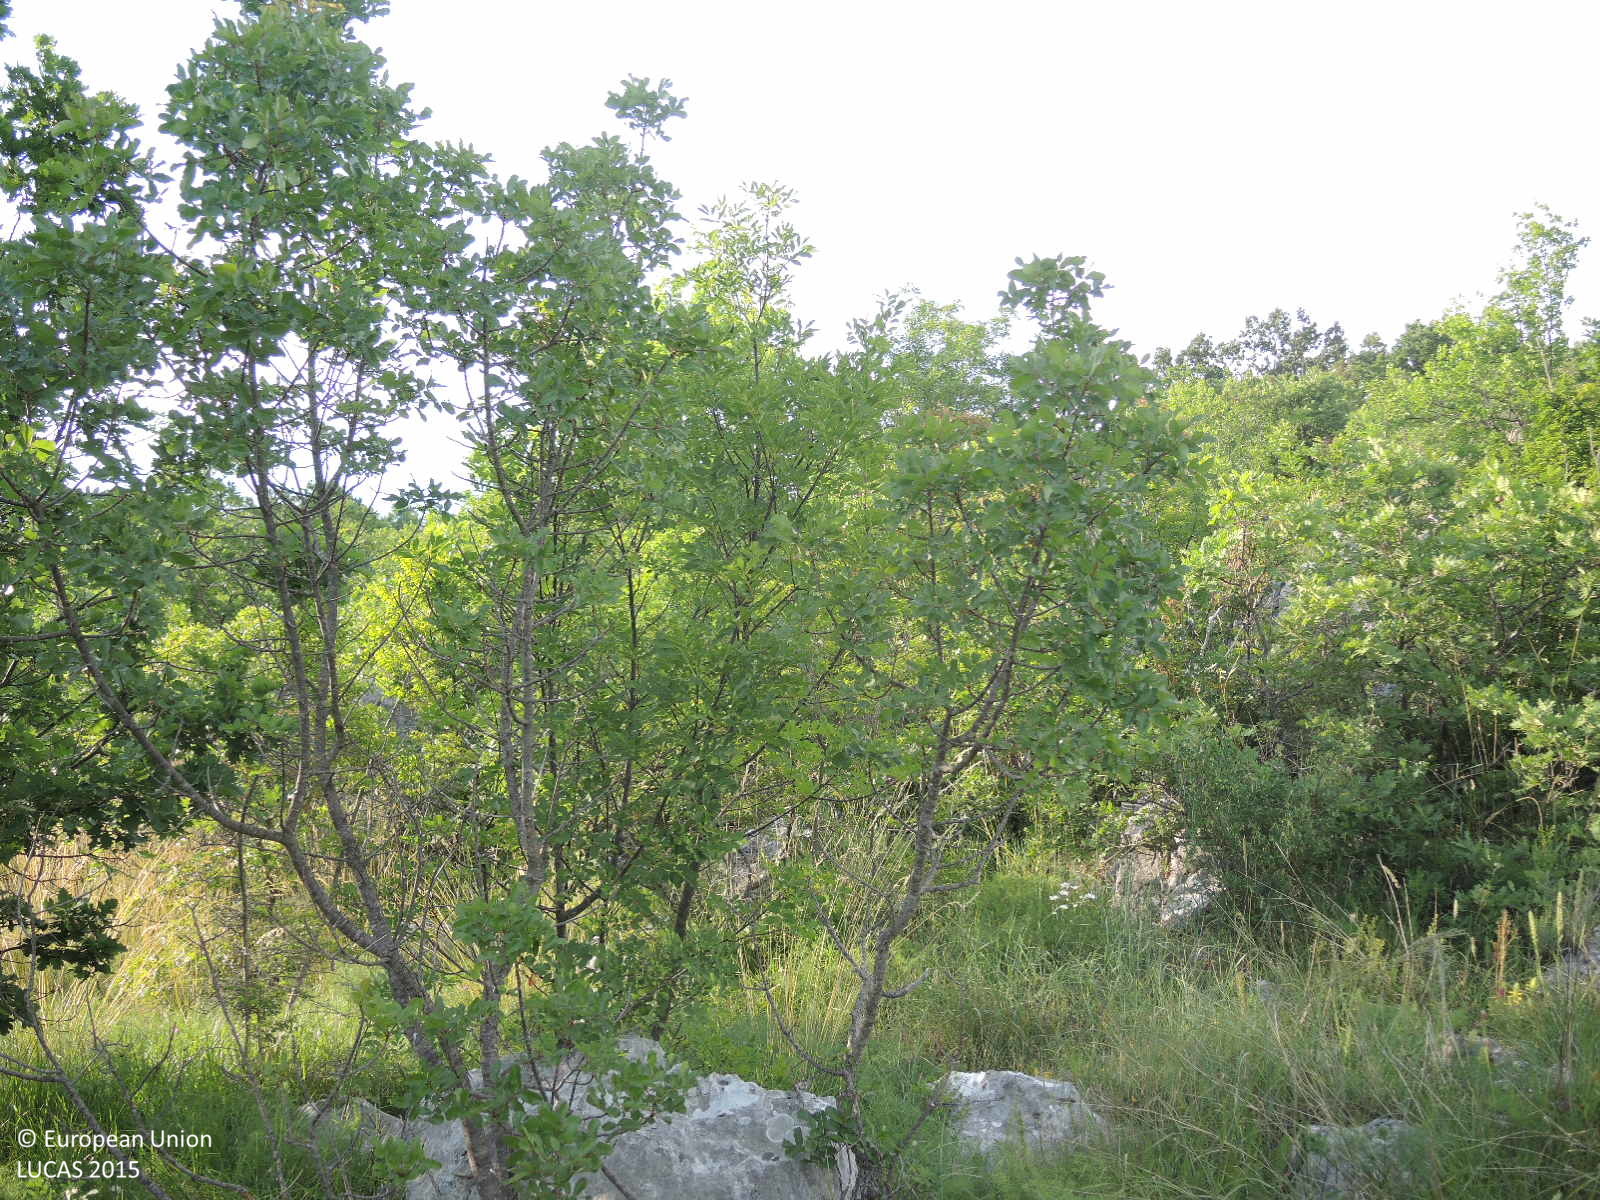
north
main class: Woodland
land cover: Broadleaved woodland
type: thermophilous deciduous forest
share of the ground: 50 - 75 %
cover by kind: broadleaved forest trees 50 %, herbaceous plants 15 %, consolidated bare surface 15 %, shrubs 10 %, unconsolidated bare surface 10 %
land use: Semi-natural and natural areas not in use
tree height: > 5 m
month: June
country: HR
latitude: 43.6884
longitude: 16.3060
